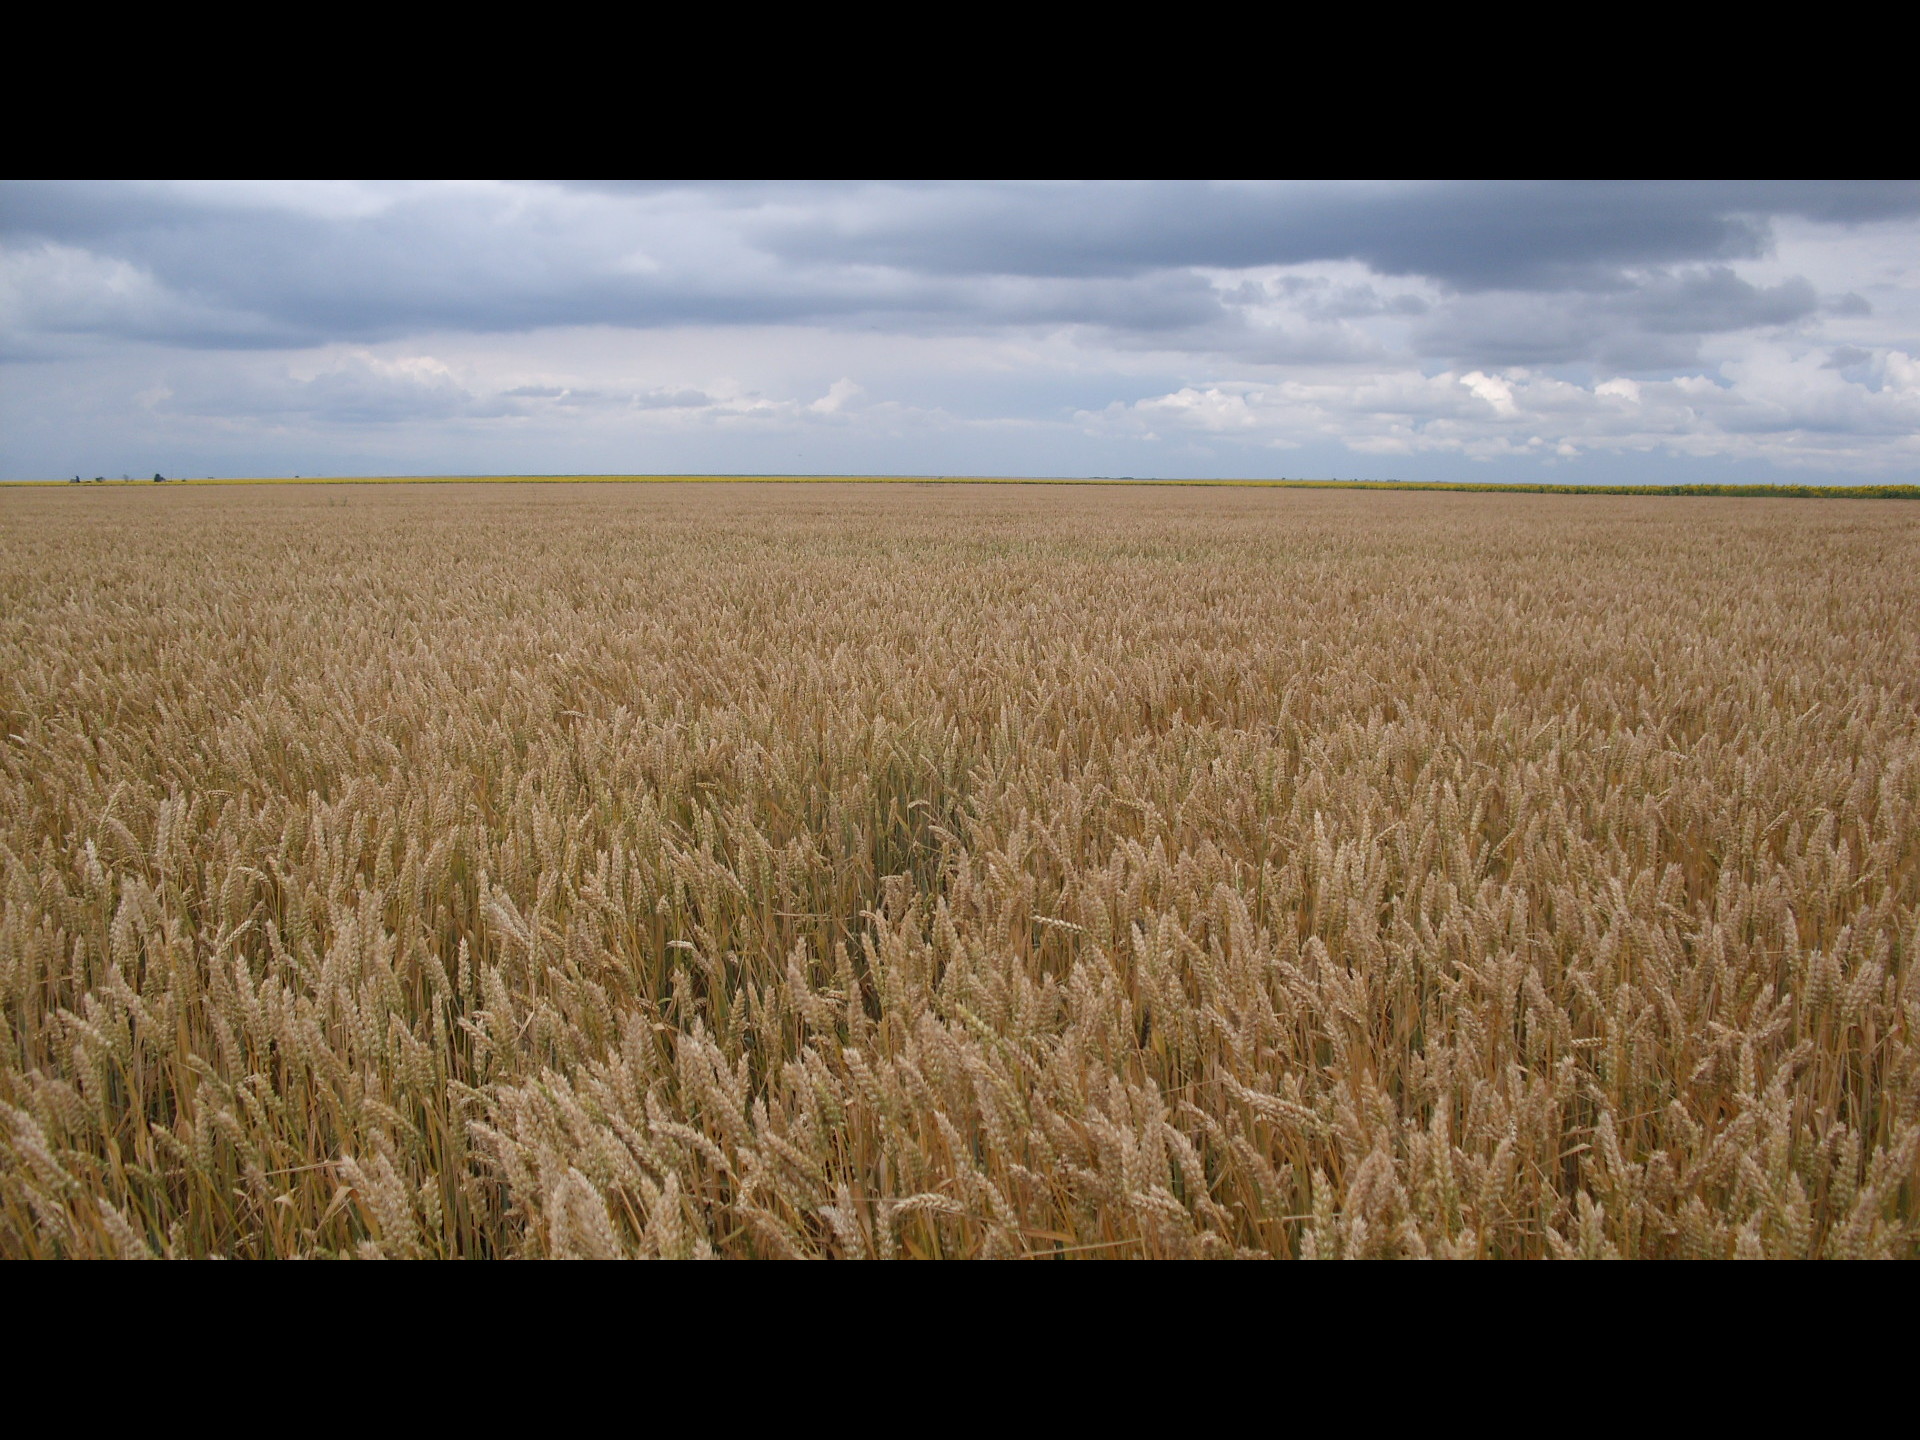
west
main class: Cropland
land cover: Common wheat
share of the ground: > 75 %
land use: Agriculture (excluding fallow land and kitchen gardens)
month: June
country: BG
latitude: 43.6178
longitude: 23.4401
